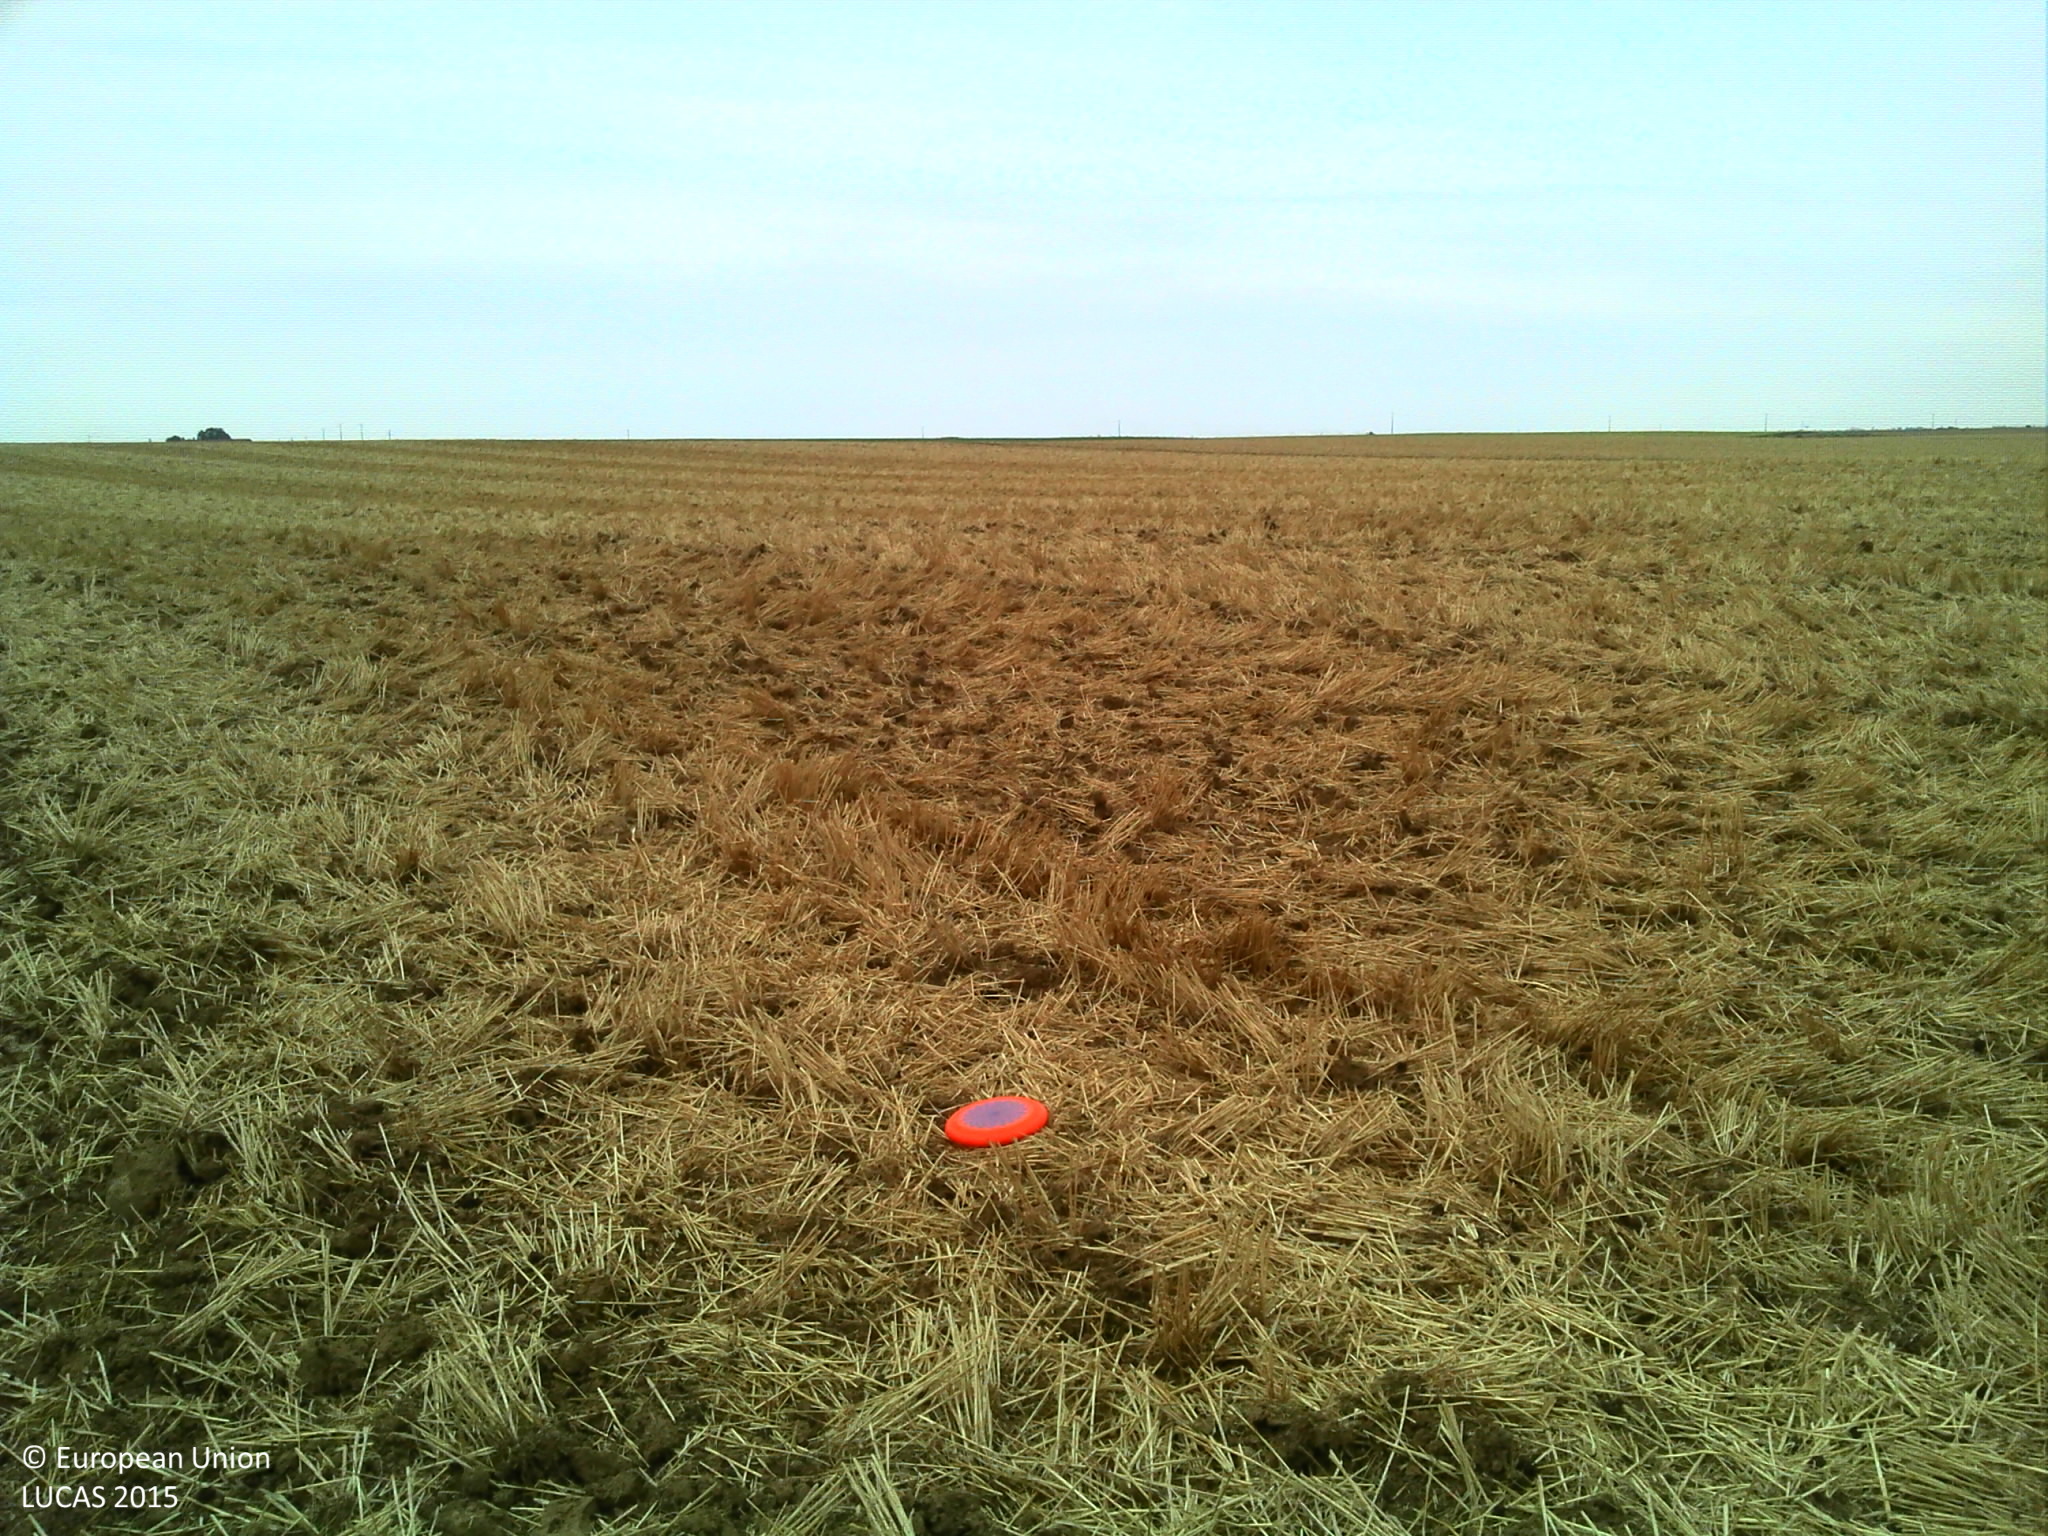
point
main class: Cropland
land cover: Common wheat
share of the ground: 10 - 25 %
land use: Agriculture (excluding fallow land and kitchen gardens)
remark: Harvested field
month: August
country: FR
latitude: 48.2419
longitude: 2.5437
